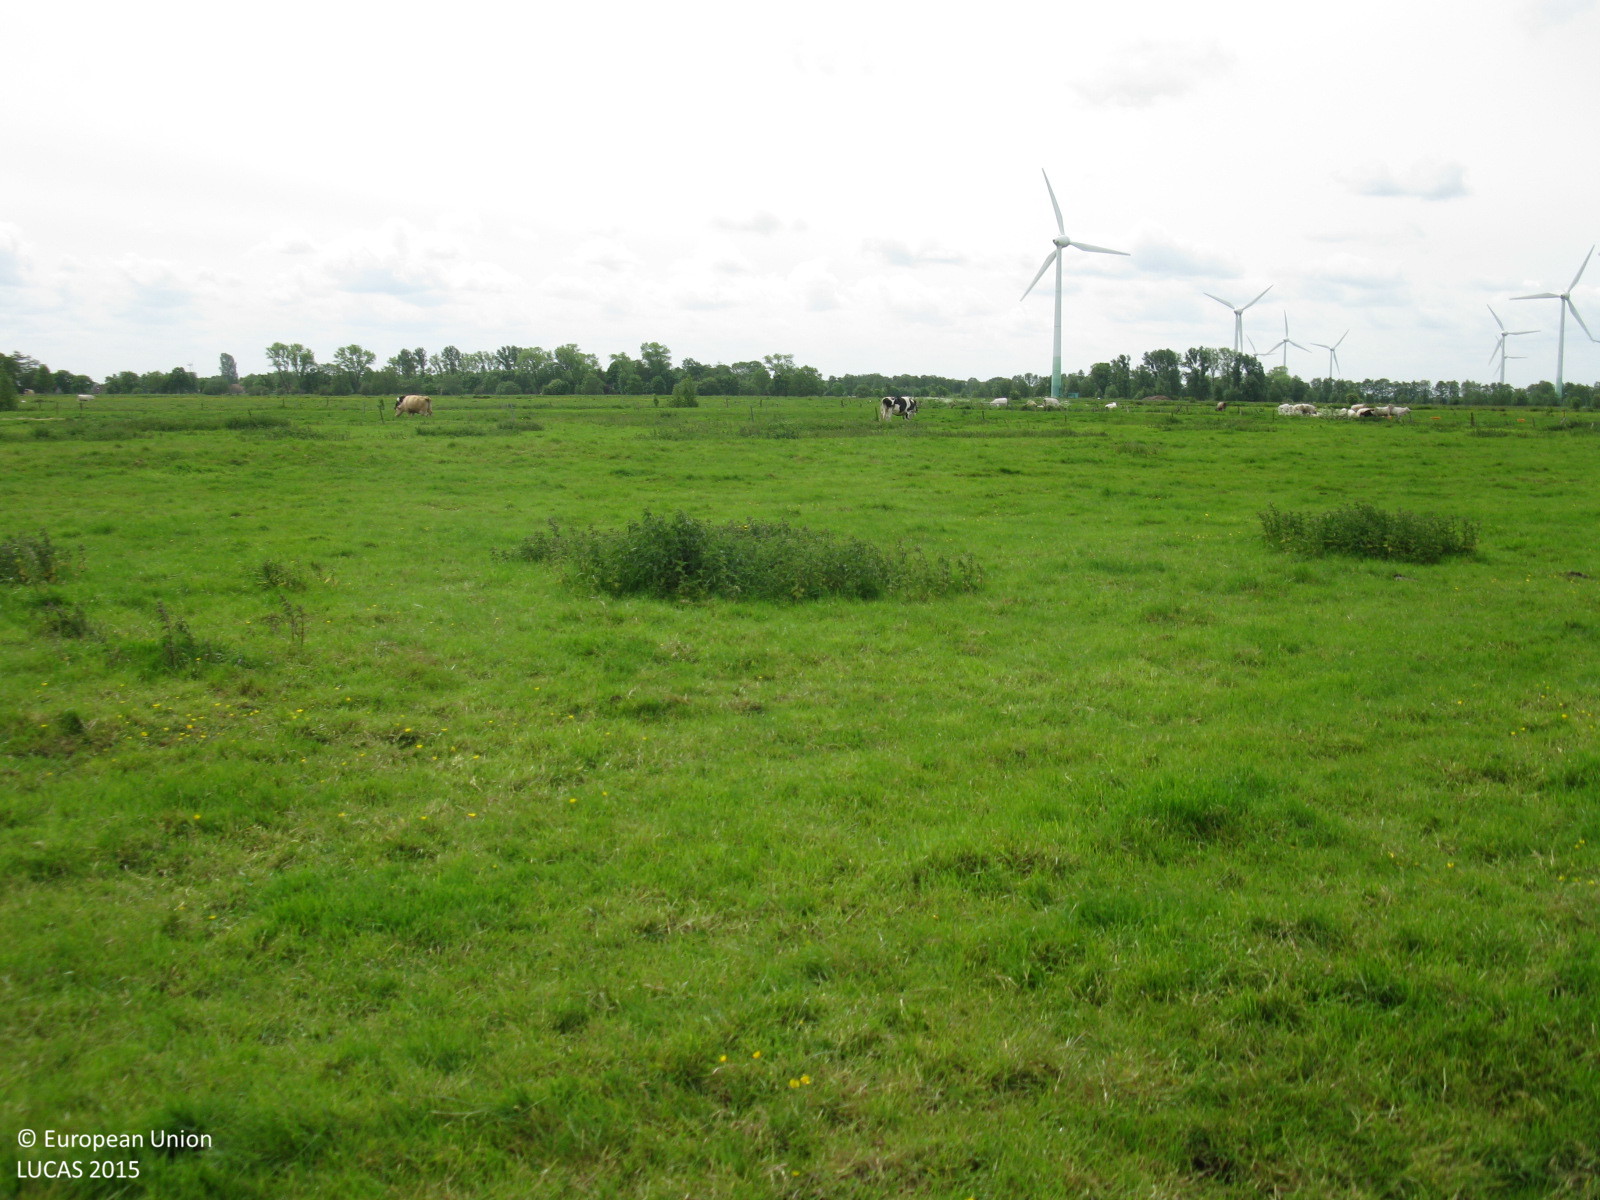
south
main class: Grassland
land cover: Grassland without tree/shrub cover
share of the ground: > 75 %
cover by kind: herbaceous plants 100 %
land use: Agriculture (excluding fallow land and kitchen gardens)
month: June
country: DE
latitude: 53.2105
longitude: 7.3203
